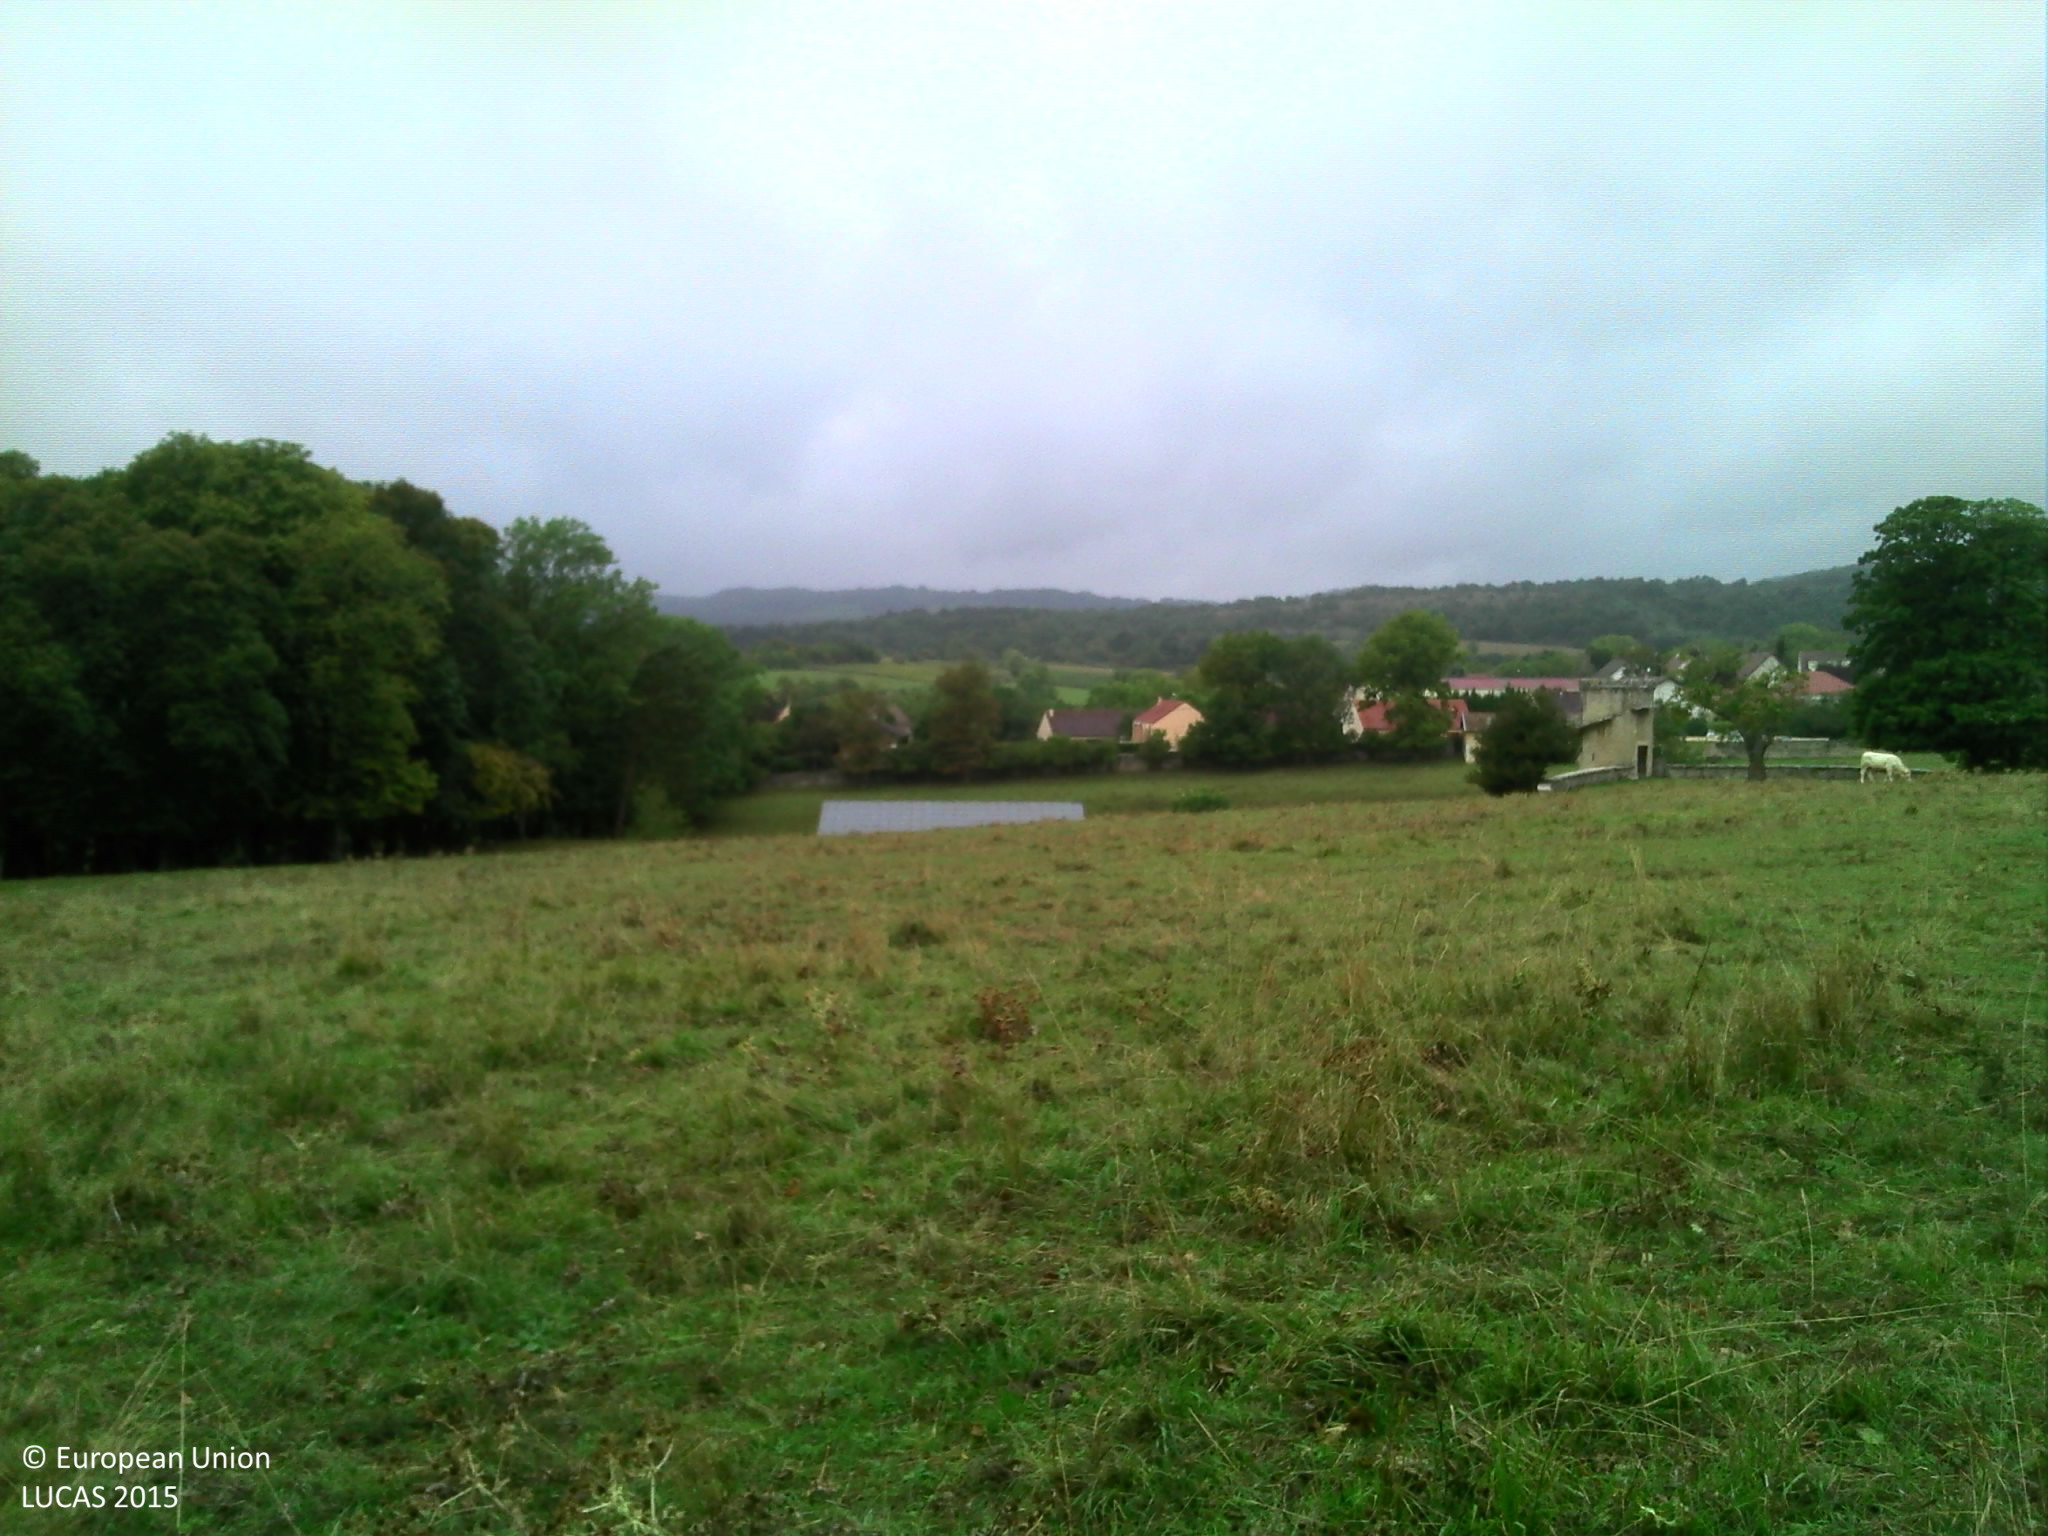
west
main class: Grassland
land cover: Grassland without tree/shrub cover
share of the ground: > 75 %
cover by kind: herbaceous plants 100 %
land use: Agriculture (excluding fallow land and kitchen gardens)
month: September
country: FR
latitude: 47.0536
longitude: 4.7744
